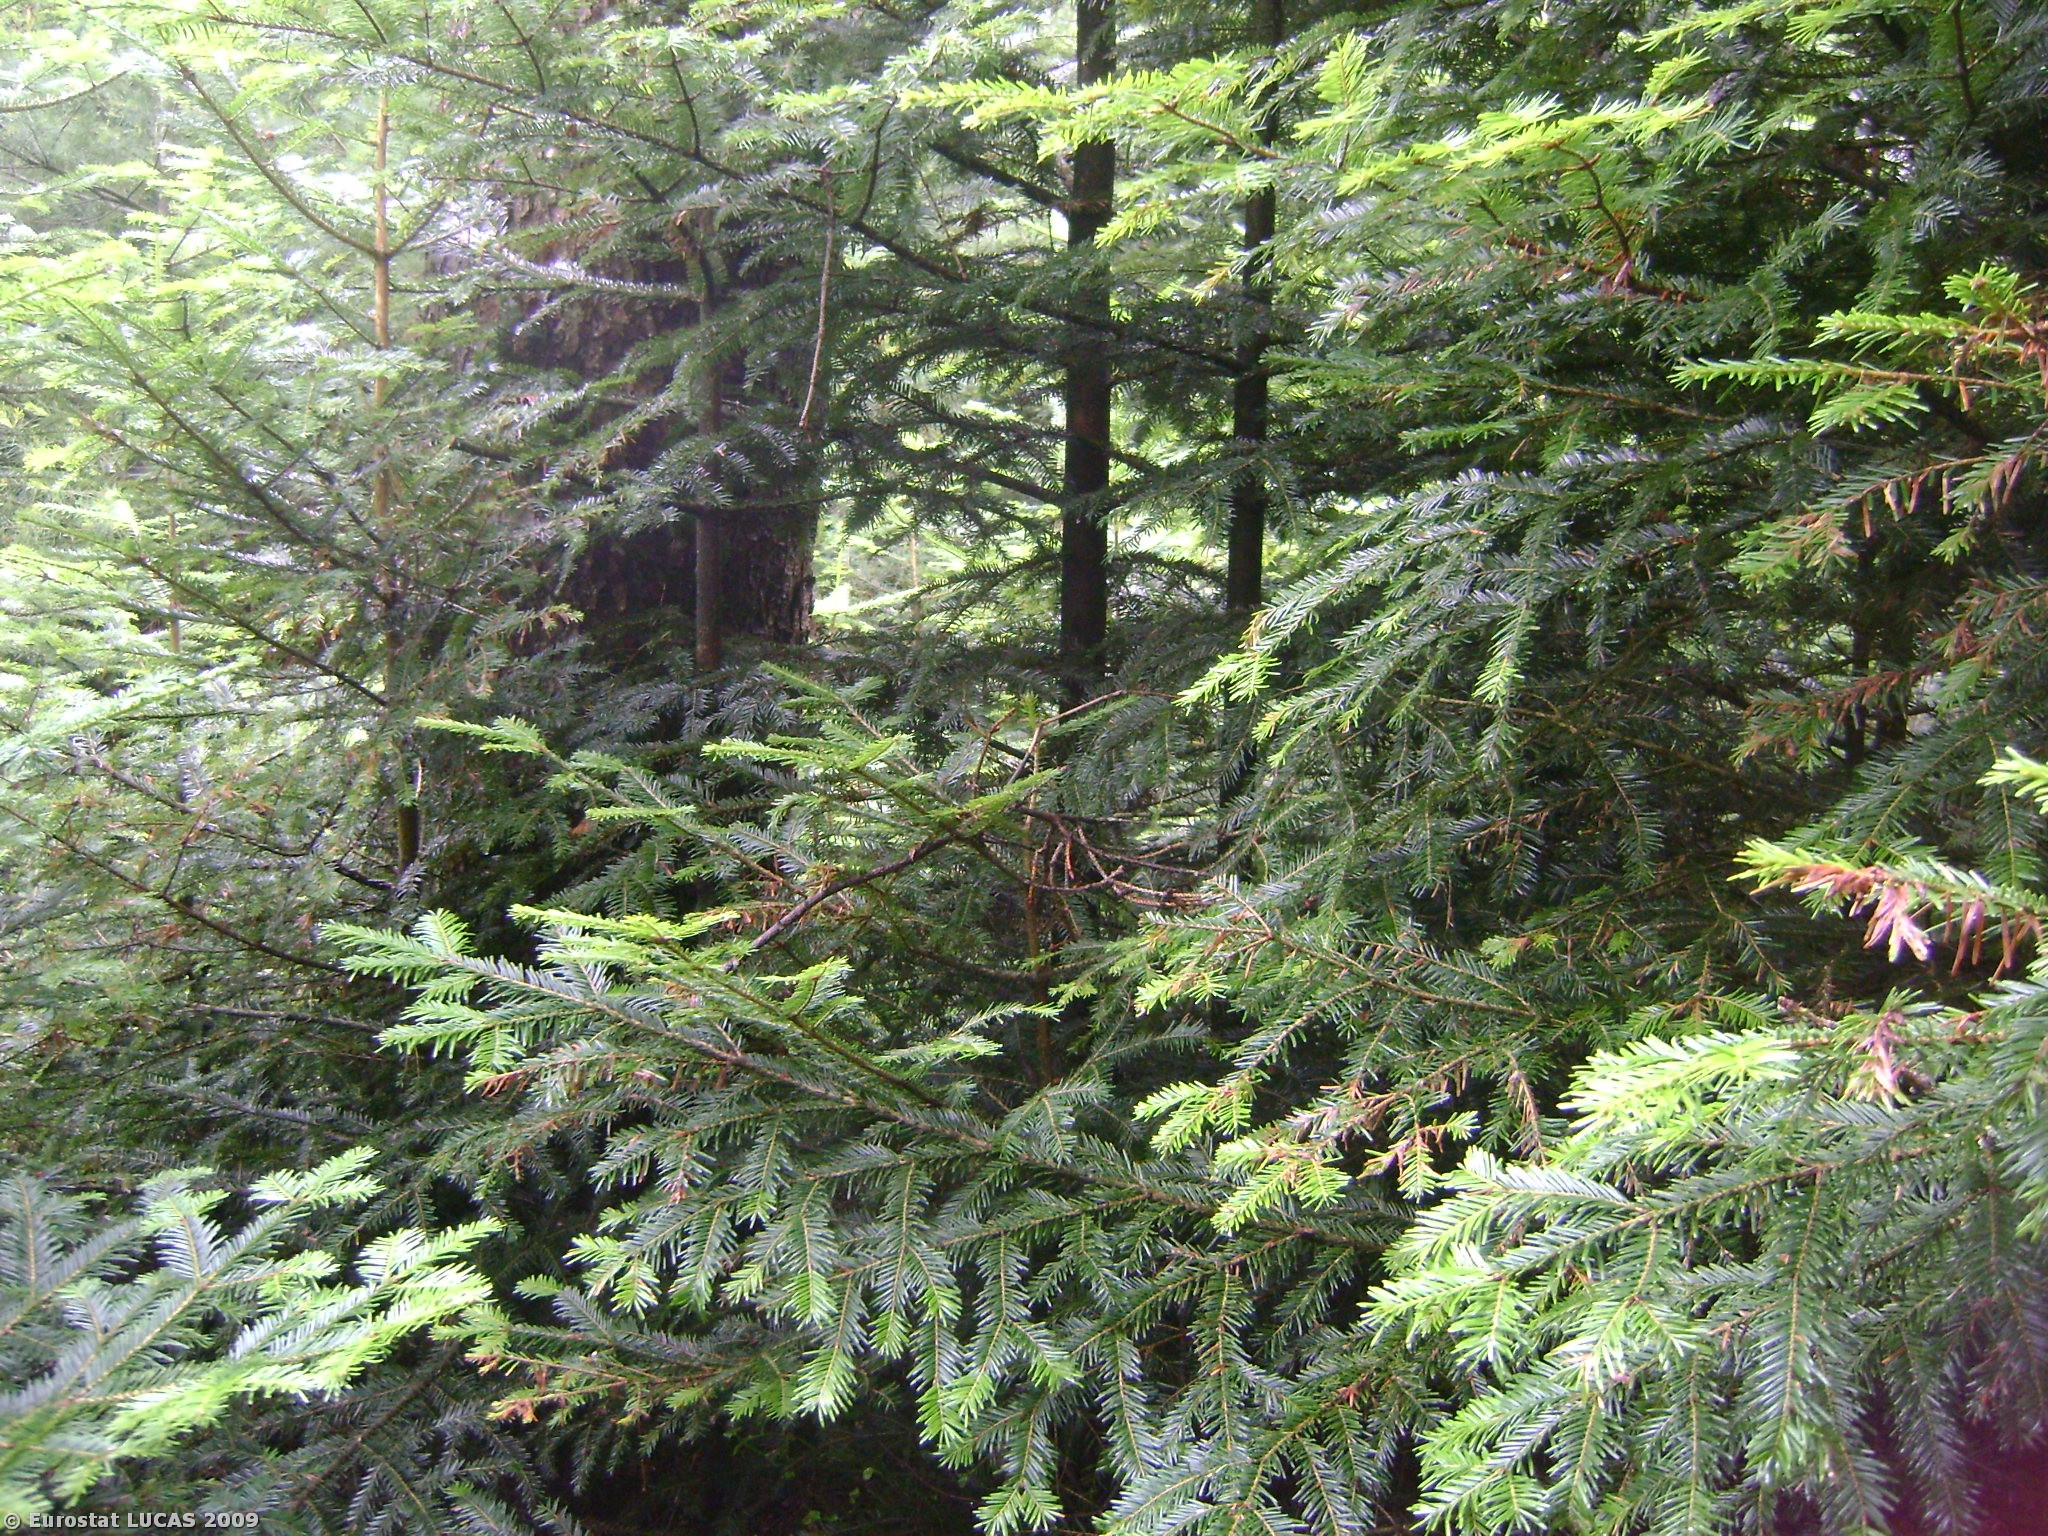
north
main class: Woodland
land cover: Coniferous woodland
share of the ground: > 75 %
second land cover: Shrubland with sparse tree cover
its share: 10 - 25 %
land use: Forestry
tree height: < 5 m
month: June
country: AT
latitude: 48.1041
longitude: 13.2355
